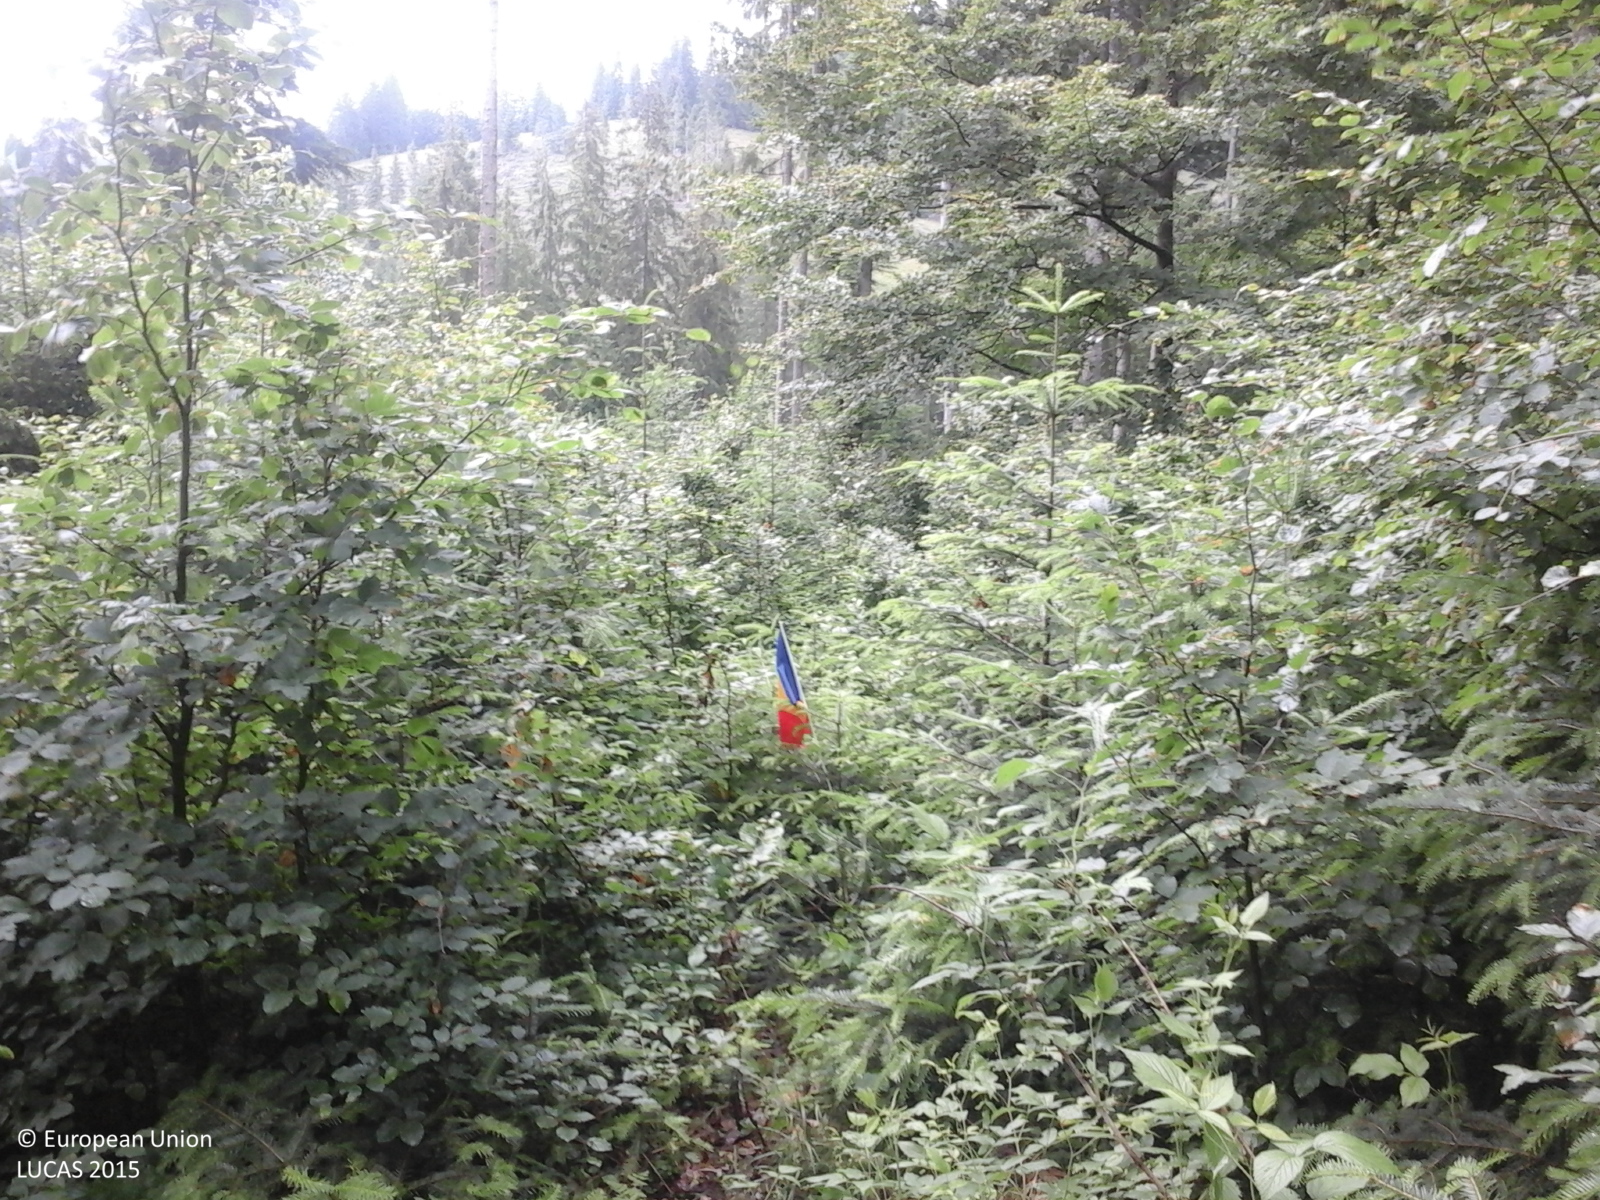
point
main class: Woodland
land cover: Spruce dominated mixed woodland
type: alpine coniferous forest
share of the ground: > 75 %
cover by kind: coniferous forest trees 70 %, broadleaved forest trees 25 %, shrubs 5 %
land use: Forestry
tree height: > 5 m
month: June
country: RO
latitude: 47.3995
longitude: 25.2001
